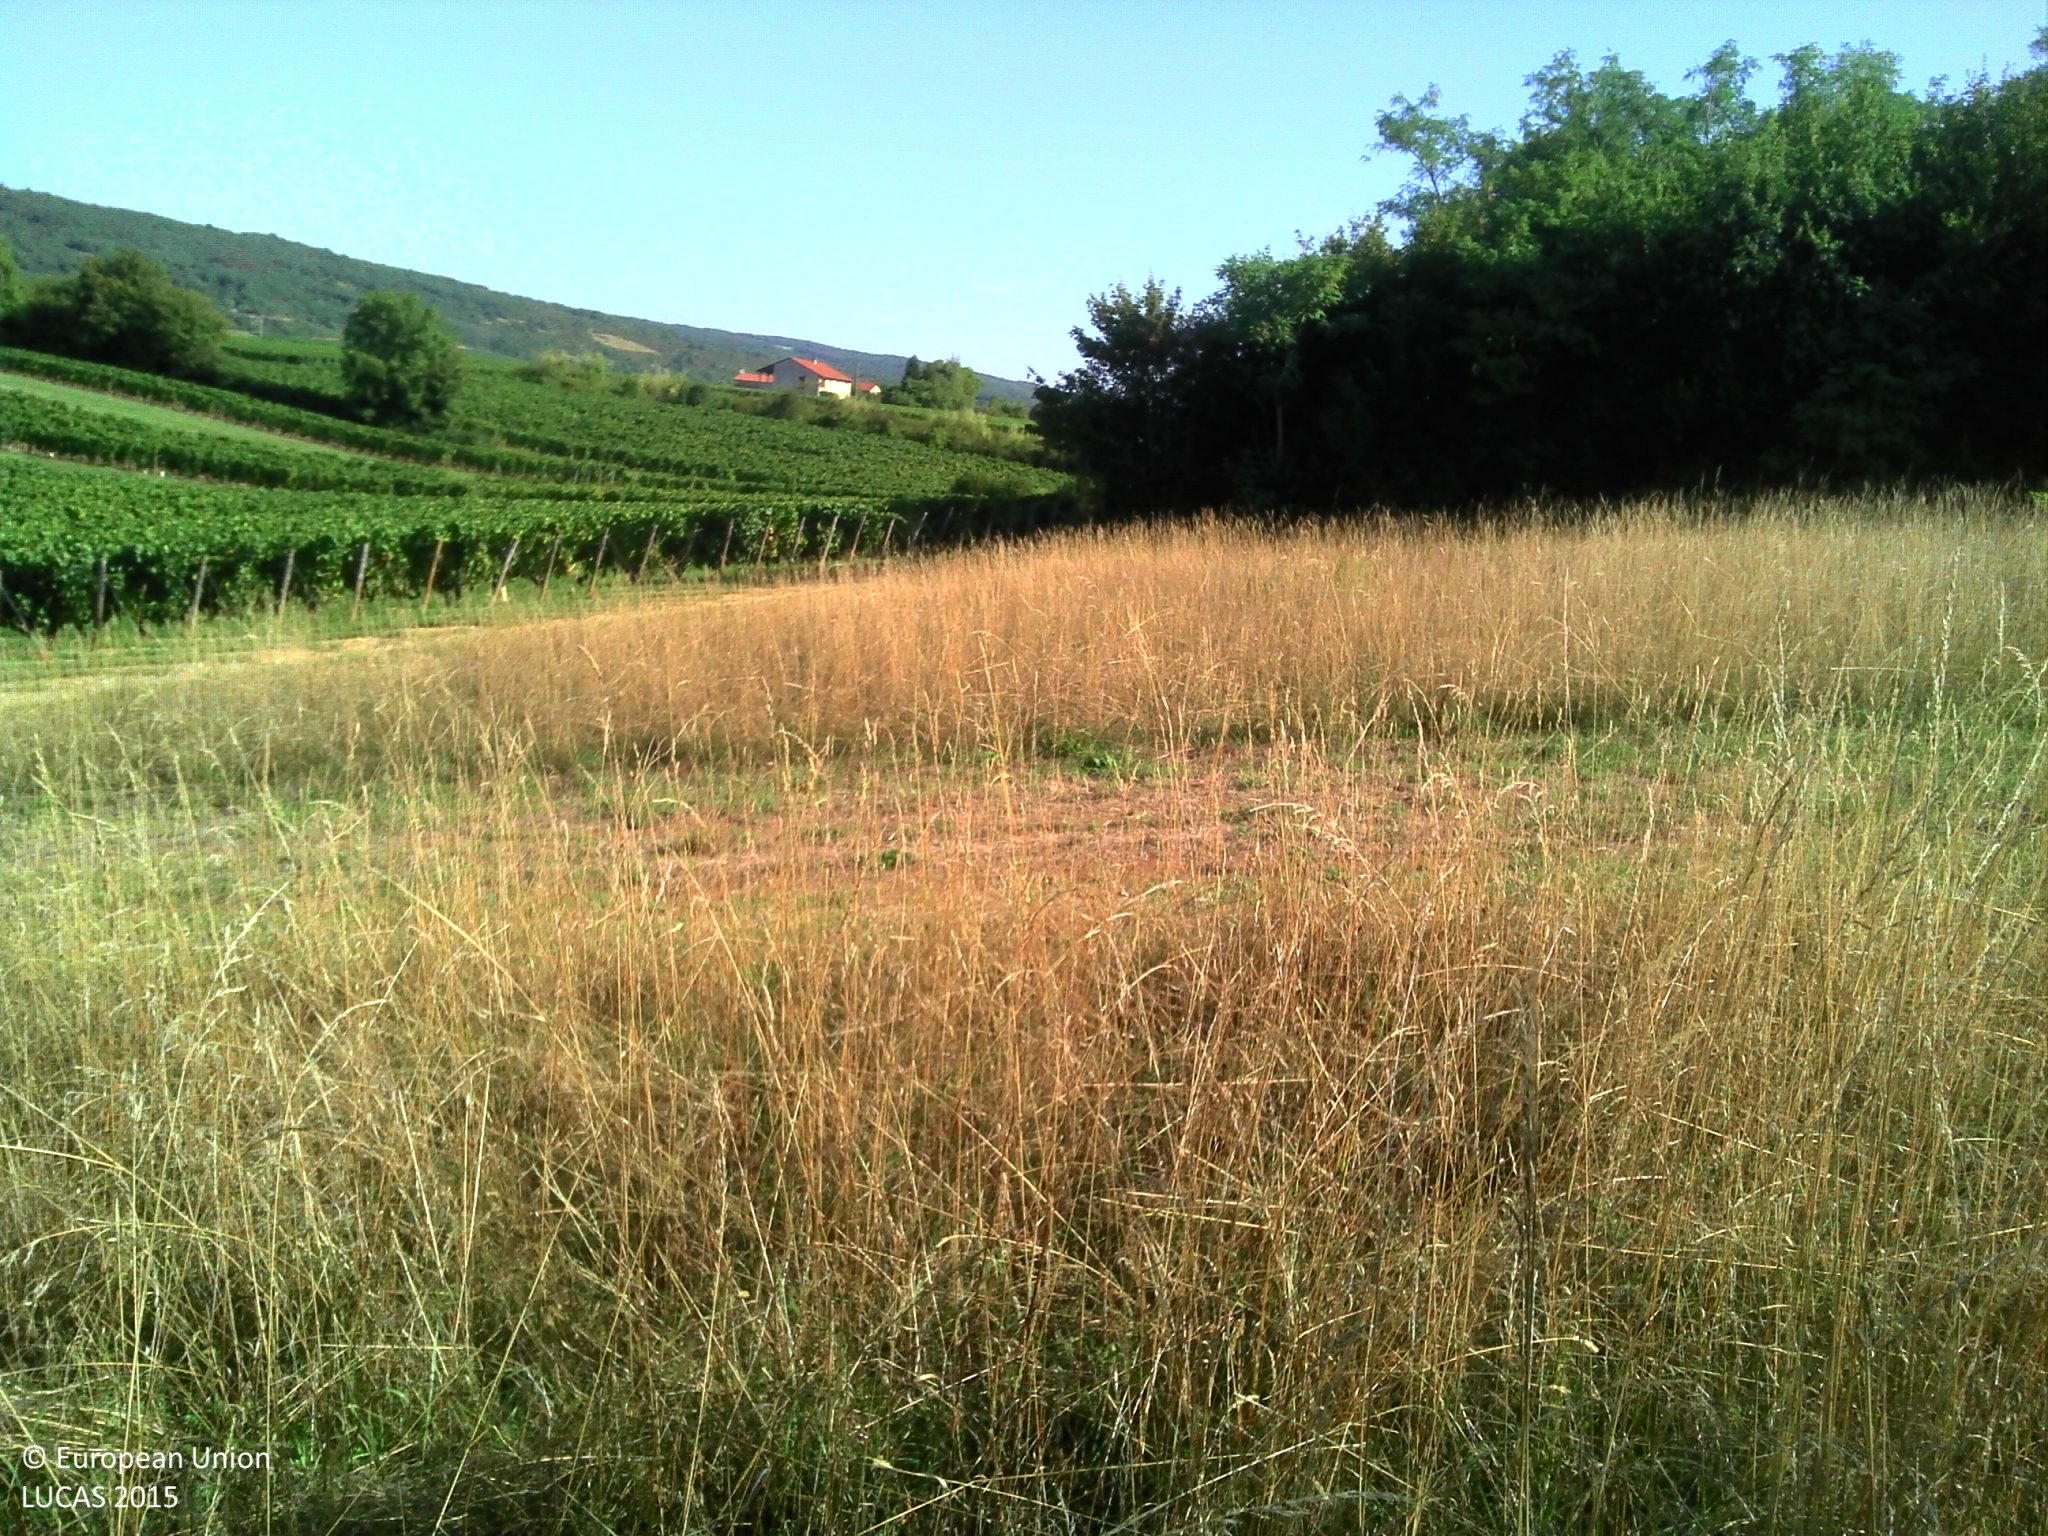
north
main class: Woodland
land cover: Broadleaved woodland
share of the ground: > 75 %
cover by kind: broadleaved forest trees 100 %
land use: Agriculture (excluding fallow land and kitchen gardens)
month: August
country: FR
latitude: 46.4584
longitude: 4.7807
